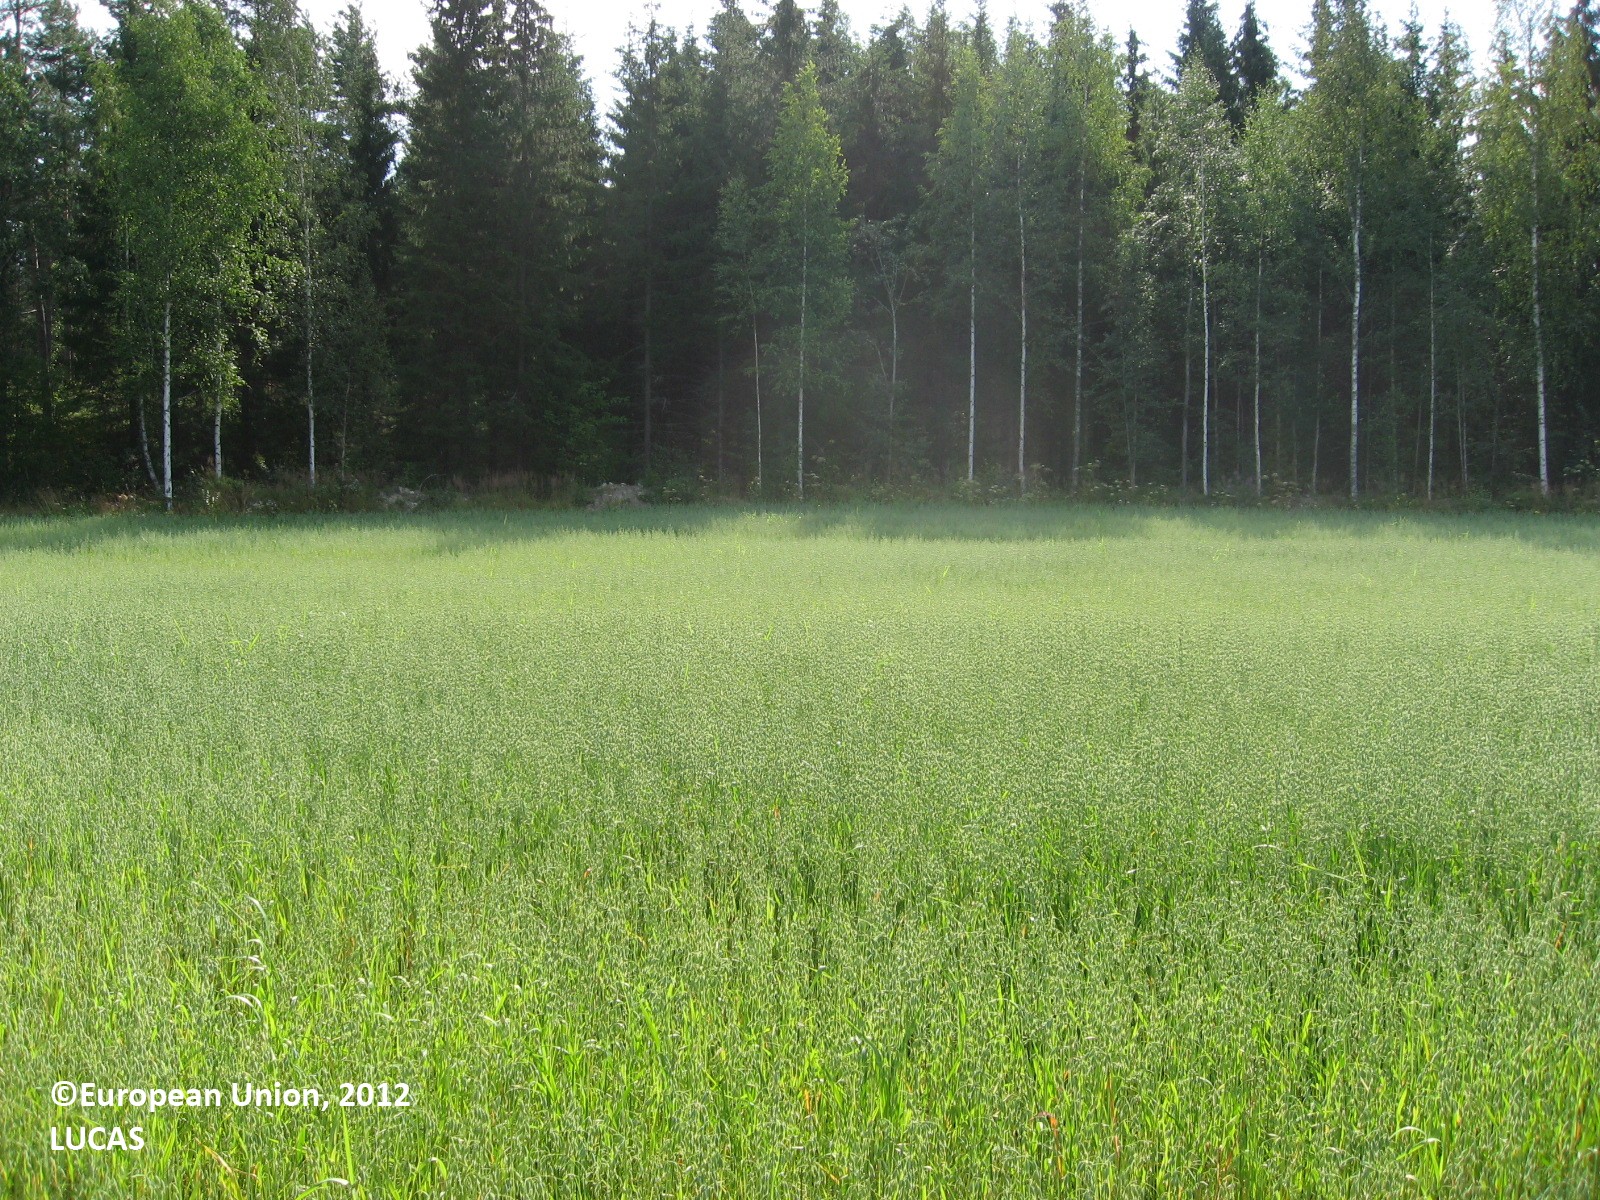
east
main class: Cropland
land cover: Oats
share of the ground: > 75 %
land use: Agriculture (excluding fallow land and kitchen gardens)
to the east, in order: Oats; Grass margins; Ditches and canals; Grass margins; Spruce dominated mixed woodland; Spruce dominated coniferous woodland; Spruce dominated mixed woodland
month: August
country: FI
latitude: 61.5147
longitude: 25.9392
